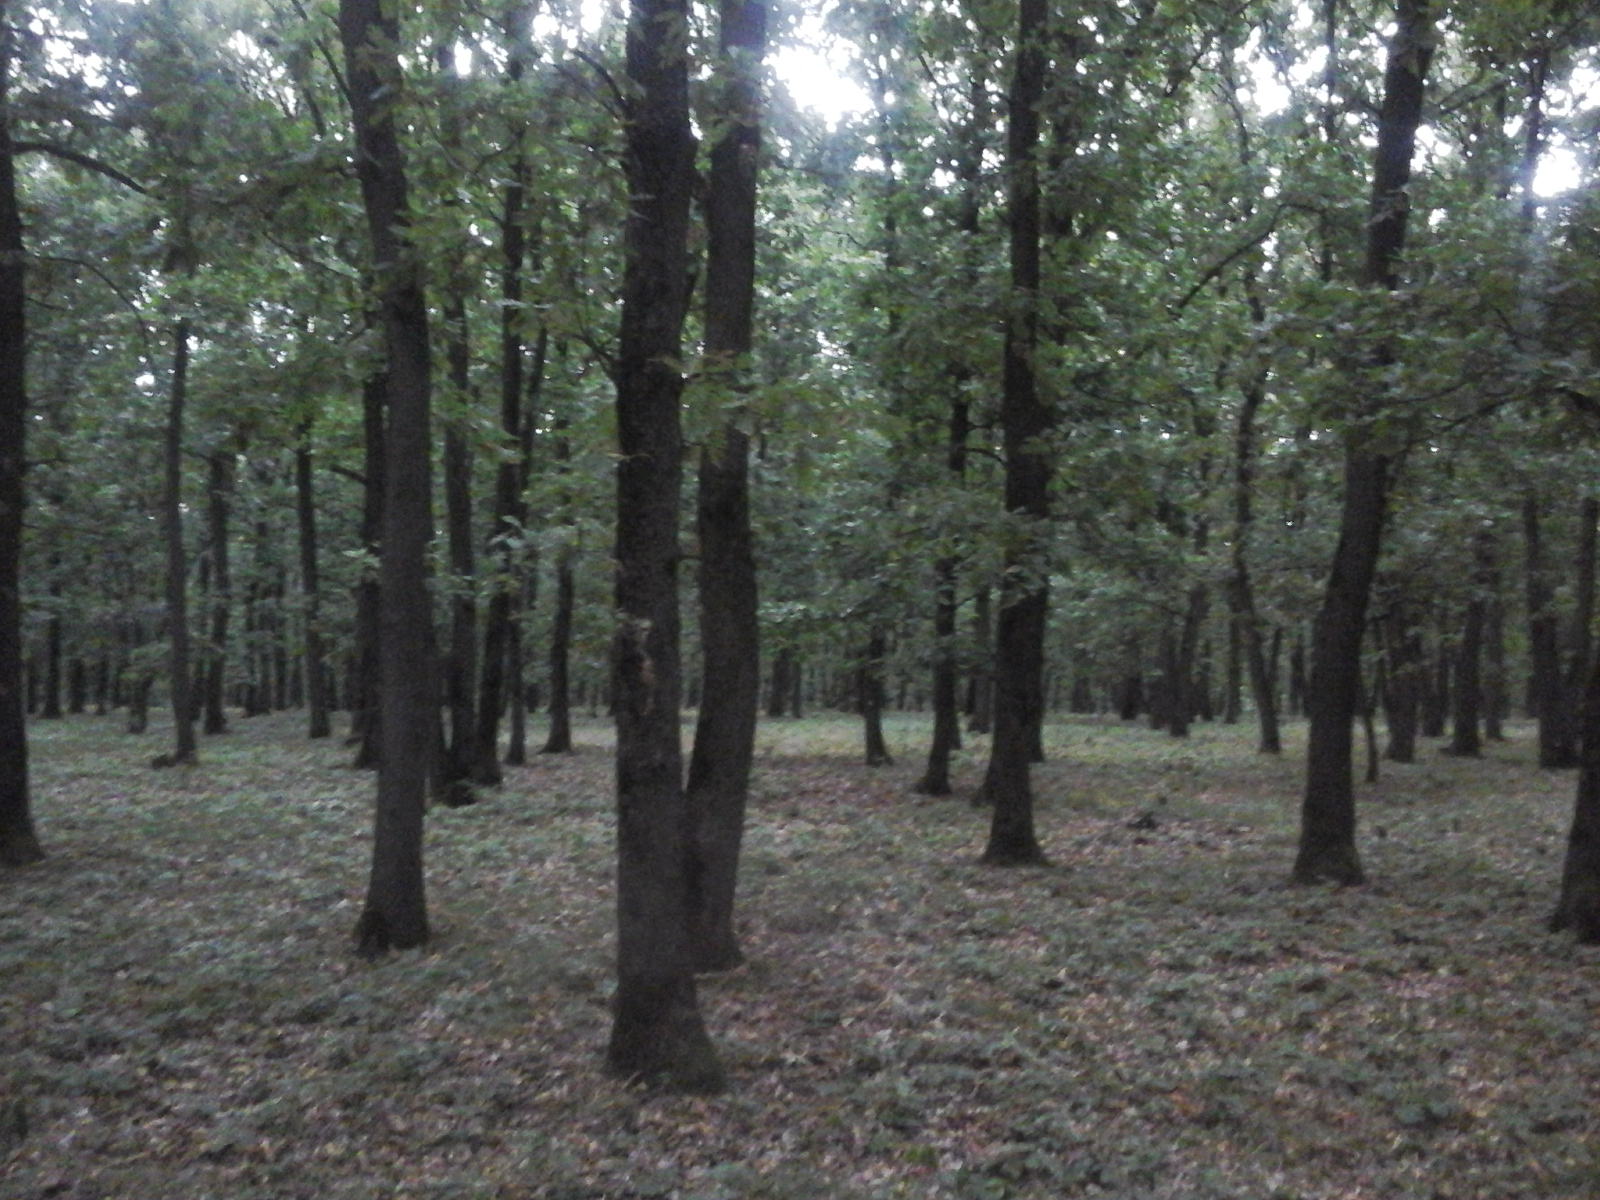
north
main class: Woodland
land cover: Broadleaved woodland
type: acidophilous oak and oak-birch forest
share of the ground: > 75 %
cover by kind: broadleaved forest trees 100 %
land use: Forestry
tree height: > 5 m
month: August
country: RO
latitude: 44.3536
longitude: 23.2588
